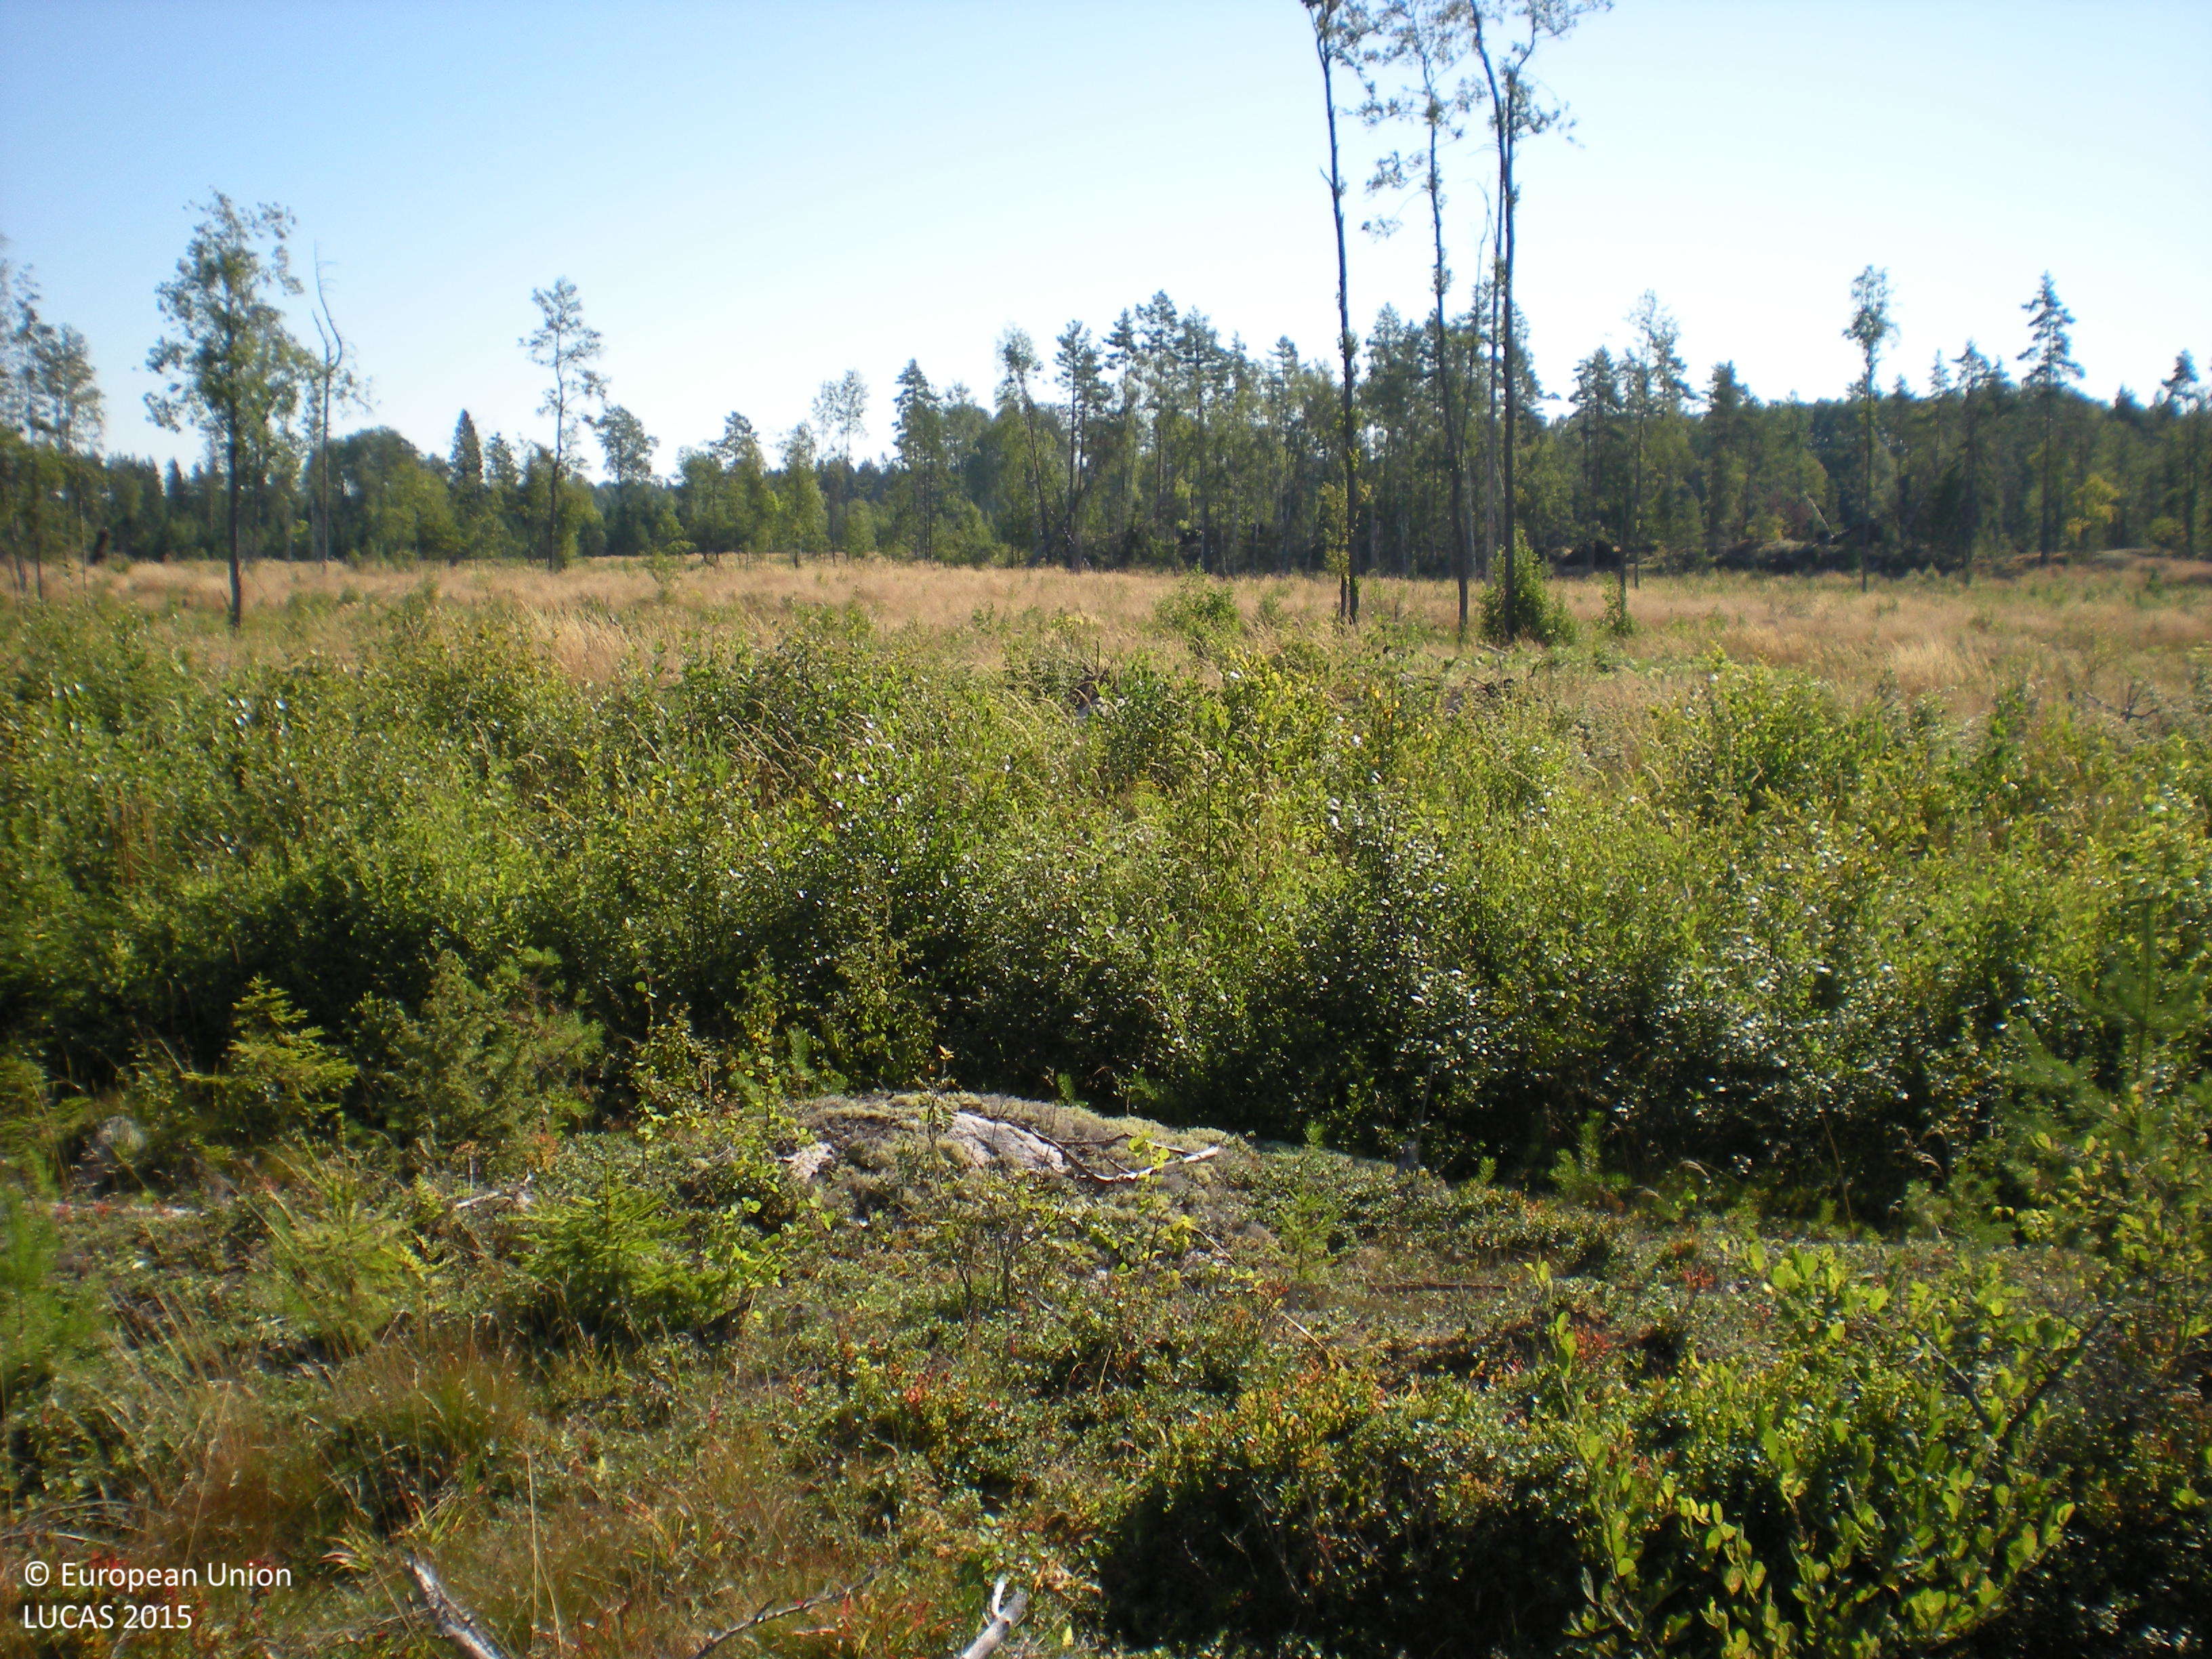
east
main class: Woodland
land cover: Broadleaved woodland
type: boreal forest
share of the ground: 10 - 25 %
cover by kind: herbaceous plants 50 %, broadleaved forest trees 25 %, shrubs 20 %, coniferous forest trees 5 %
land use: Forestry
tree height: < 5 m
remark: Clear cut
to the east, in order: Broadleaved woodland; Tracks; Broadleaved woodland; Grassland with sparse tree/shrub cover; Broadleaved woodland; Grassland with sparse tree/shrub cover; Broadleaved woodland
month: August
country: SE
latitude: 60.6096
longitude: 17.2417
